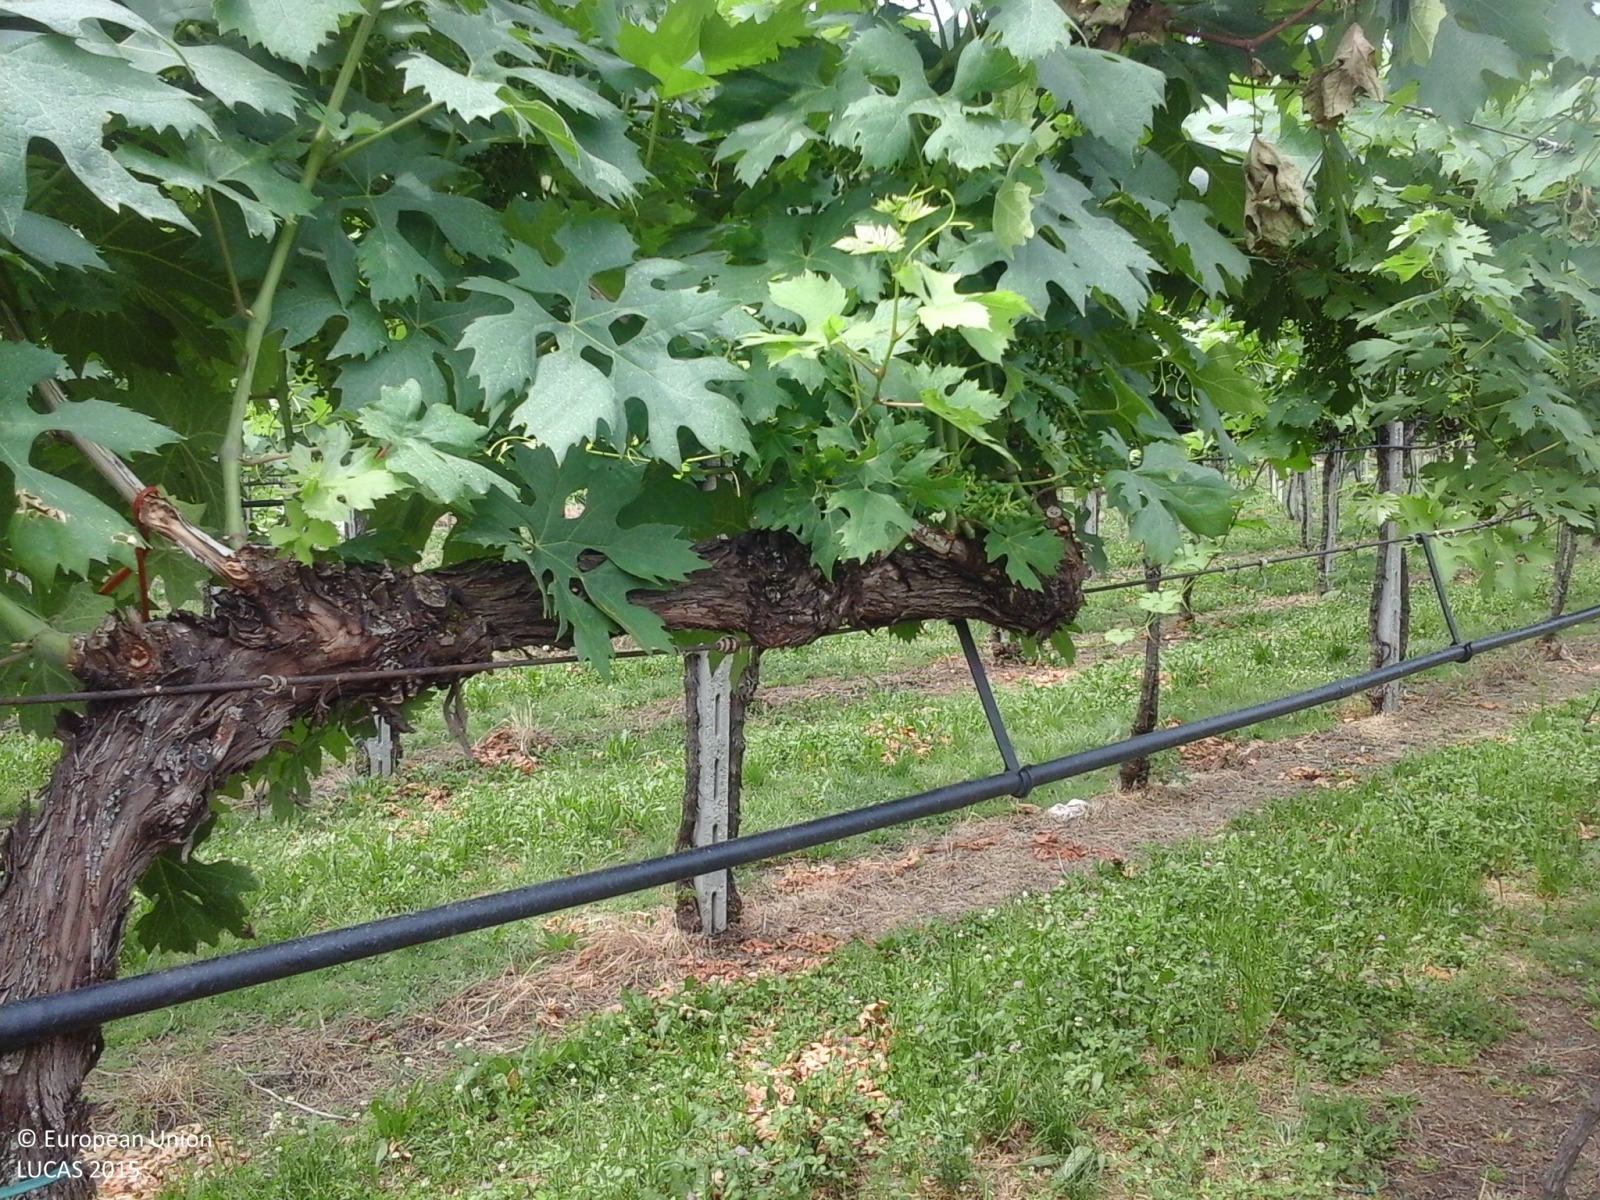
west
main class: Cropland
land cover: Vineyards
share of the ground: 50 - 75 %
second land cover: Grassland without tree/shrub cover
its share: > 75 %
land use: Agriculture (excluding fallow land and kitchen gardens)
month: June
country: IT
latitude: 45.5368
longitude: 10.8821
